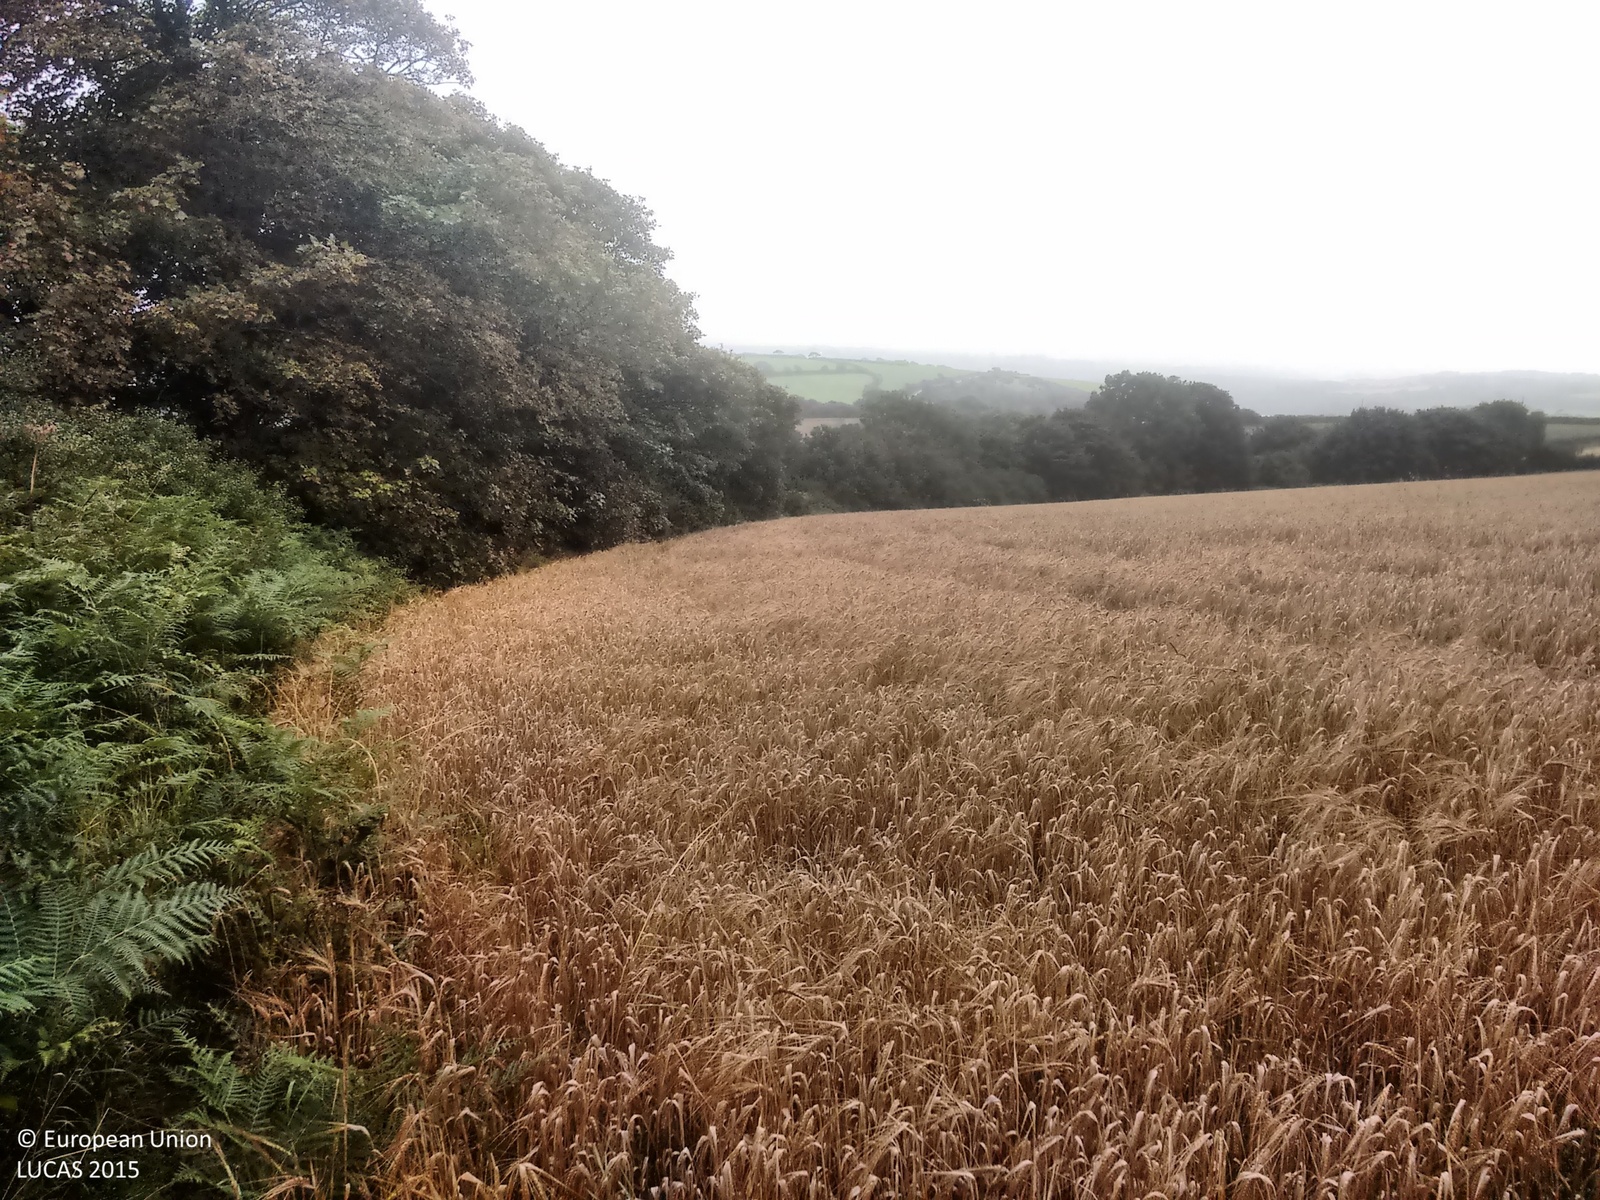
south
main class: Cropland
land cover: Barley
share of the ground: > 75 %
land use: Agriculture (excluding fallow land and kitchen gardens)
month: August
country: GB
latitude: 50.1154
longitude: -5.1525
